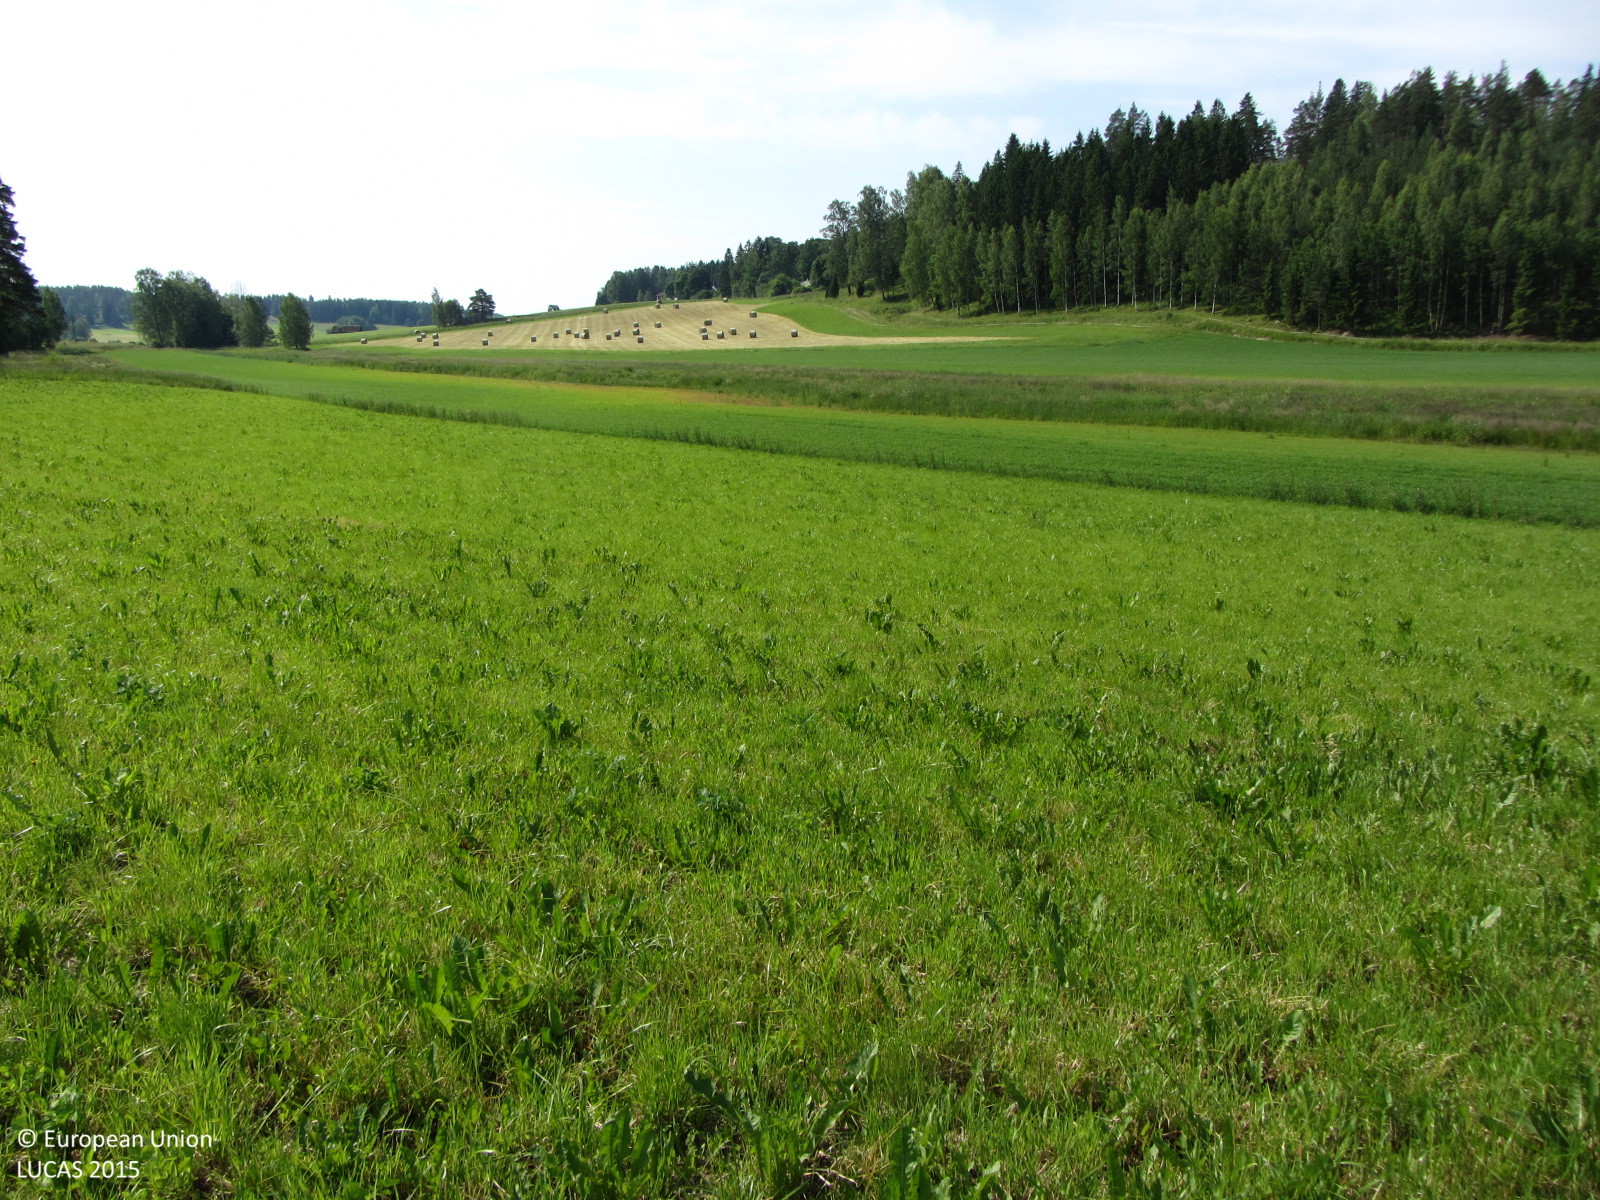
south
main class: Cropland
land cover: Temporary grasslands
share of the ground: > 75 %
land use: Agriculture (excluding fallow land and kitchen gardens)
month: July
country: FI
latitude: 60.0582
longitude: 23.6902
